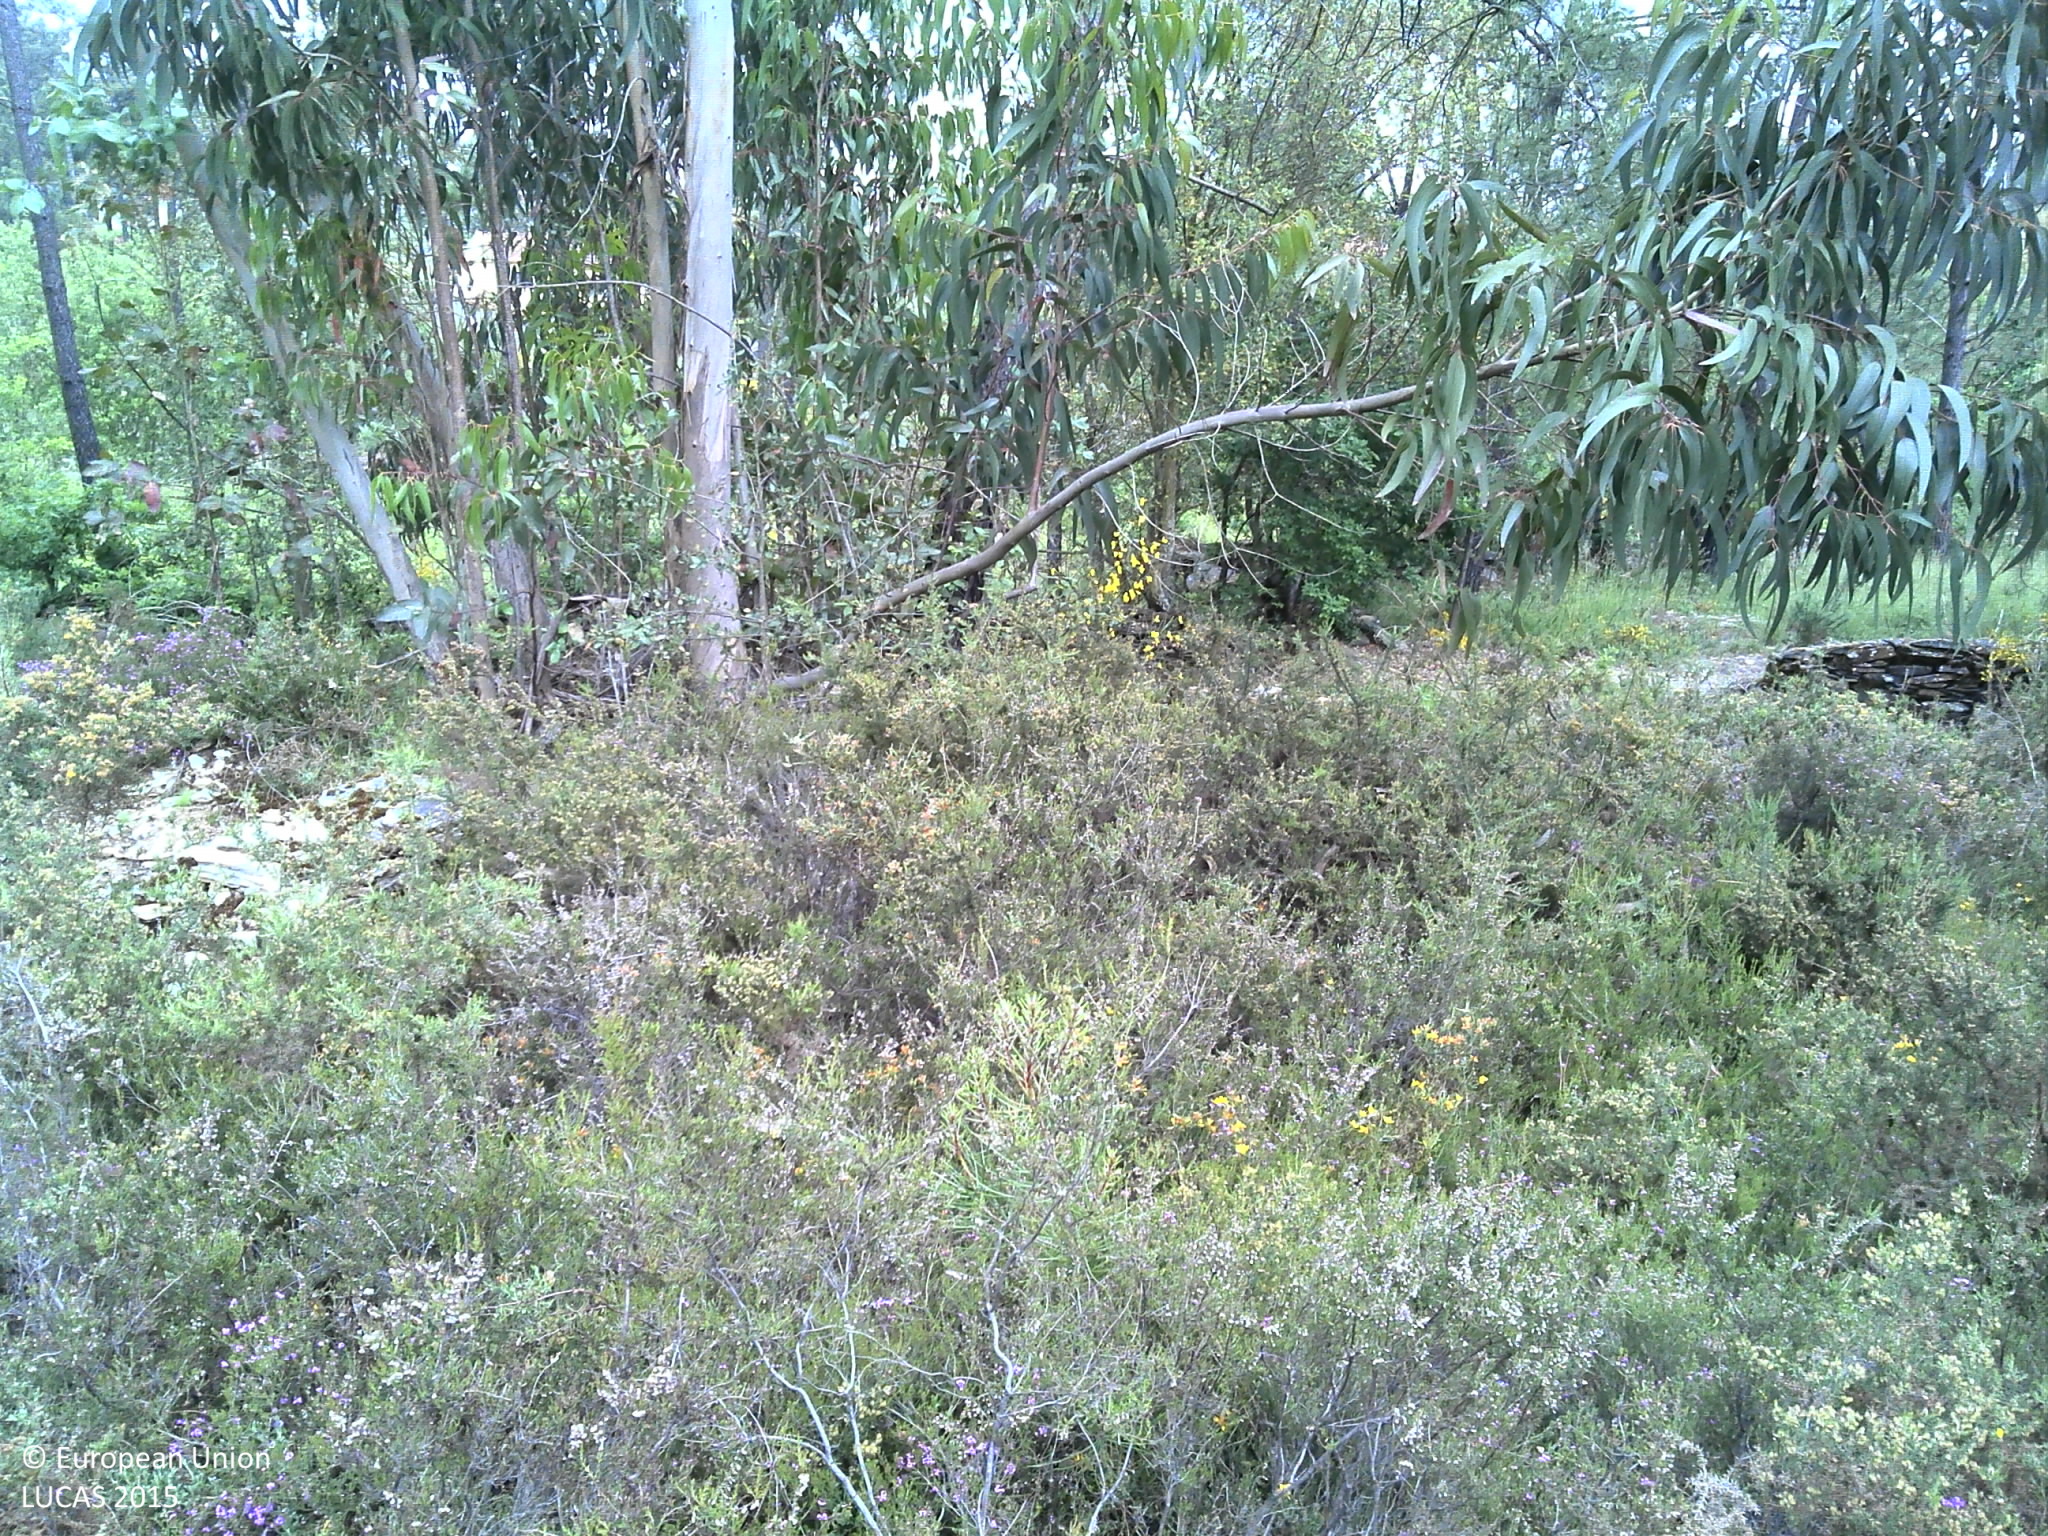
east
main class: Shrubland
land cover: Shrubland with sparse tree cover
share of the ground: > 75 %
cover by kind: shrubs 85 %, unconsolidated bare surface 10 %, broadleaved forest trees 5 %
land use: Forestry
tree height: > 5 m
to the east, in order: Shrubland with sparse tree cover; Broadleaved woodland; Dry stone walls; Tracks; Dry stone walls; Pine dominated coniferous woodland; Shrubland without tree cover; Grassland without tree/shrub cover; Rivers and streams; Shrubland without tree cover; Pine dominated coniferous woodland; Artificial constructions in urban areas; Spontaneously vegetated surfaces; Dry stone walls; Tracks; Dry stone walls; Artificial constructions in urban areas; Spontaneously vegetated surfaces
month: May
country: PT
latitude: 41.1648
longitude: -8.4423
